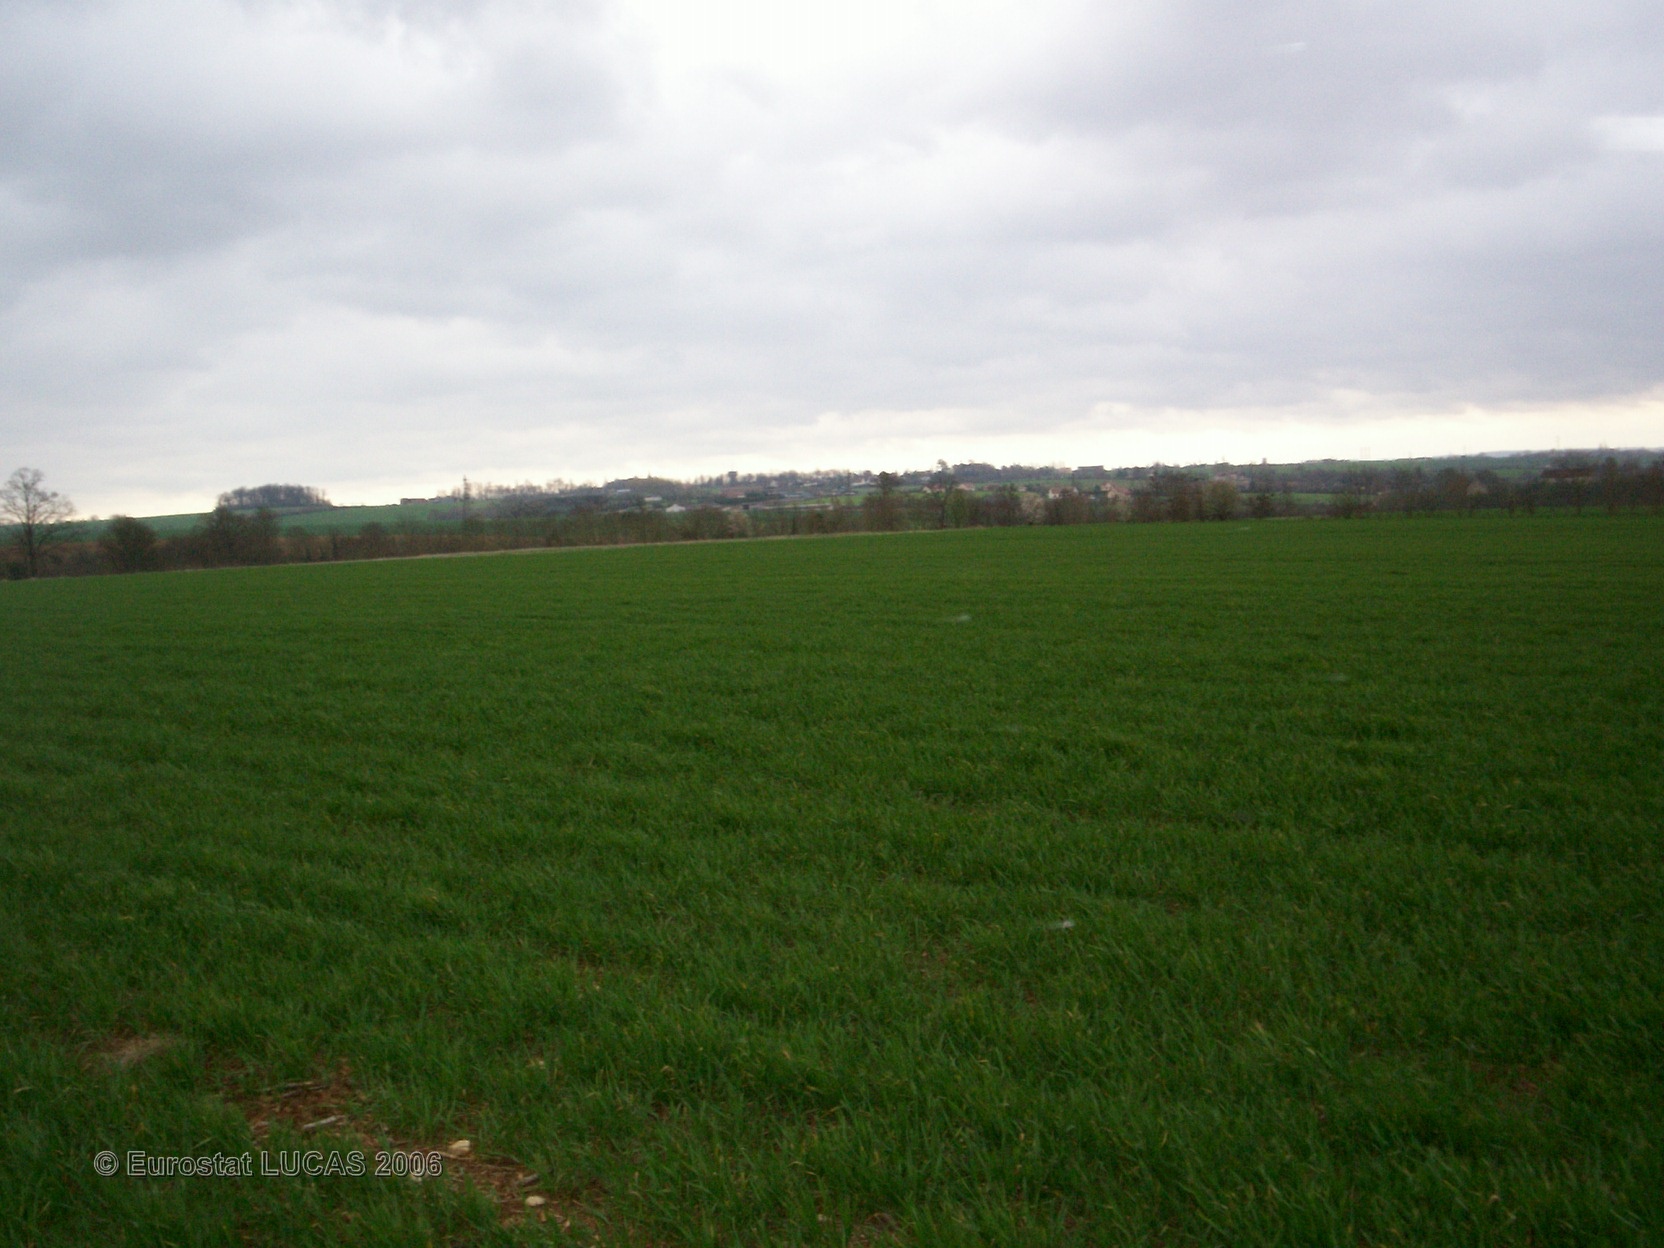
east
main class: Cropland
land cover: Common wheat
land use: Agriculture (excluding fallow land and kitchen gardens)
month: April
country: FR
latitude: 48.3587
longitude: 0.3241
